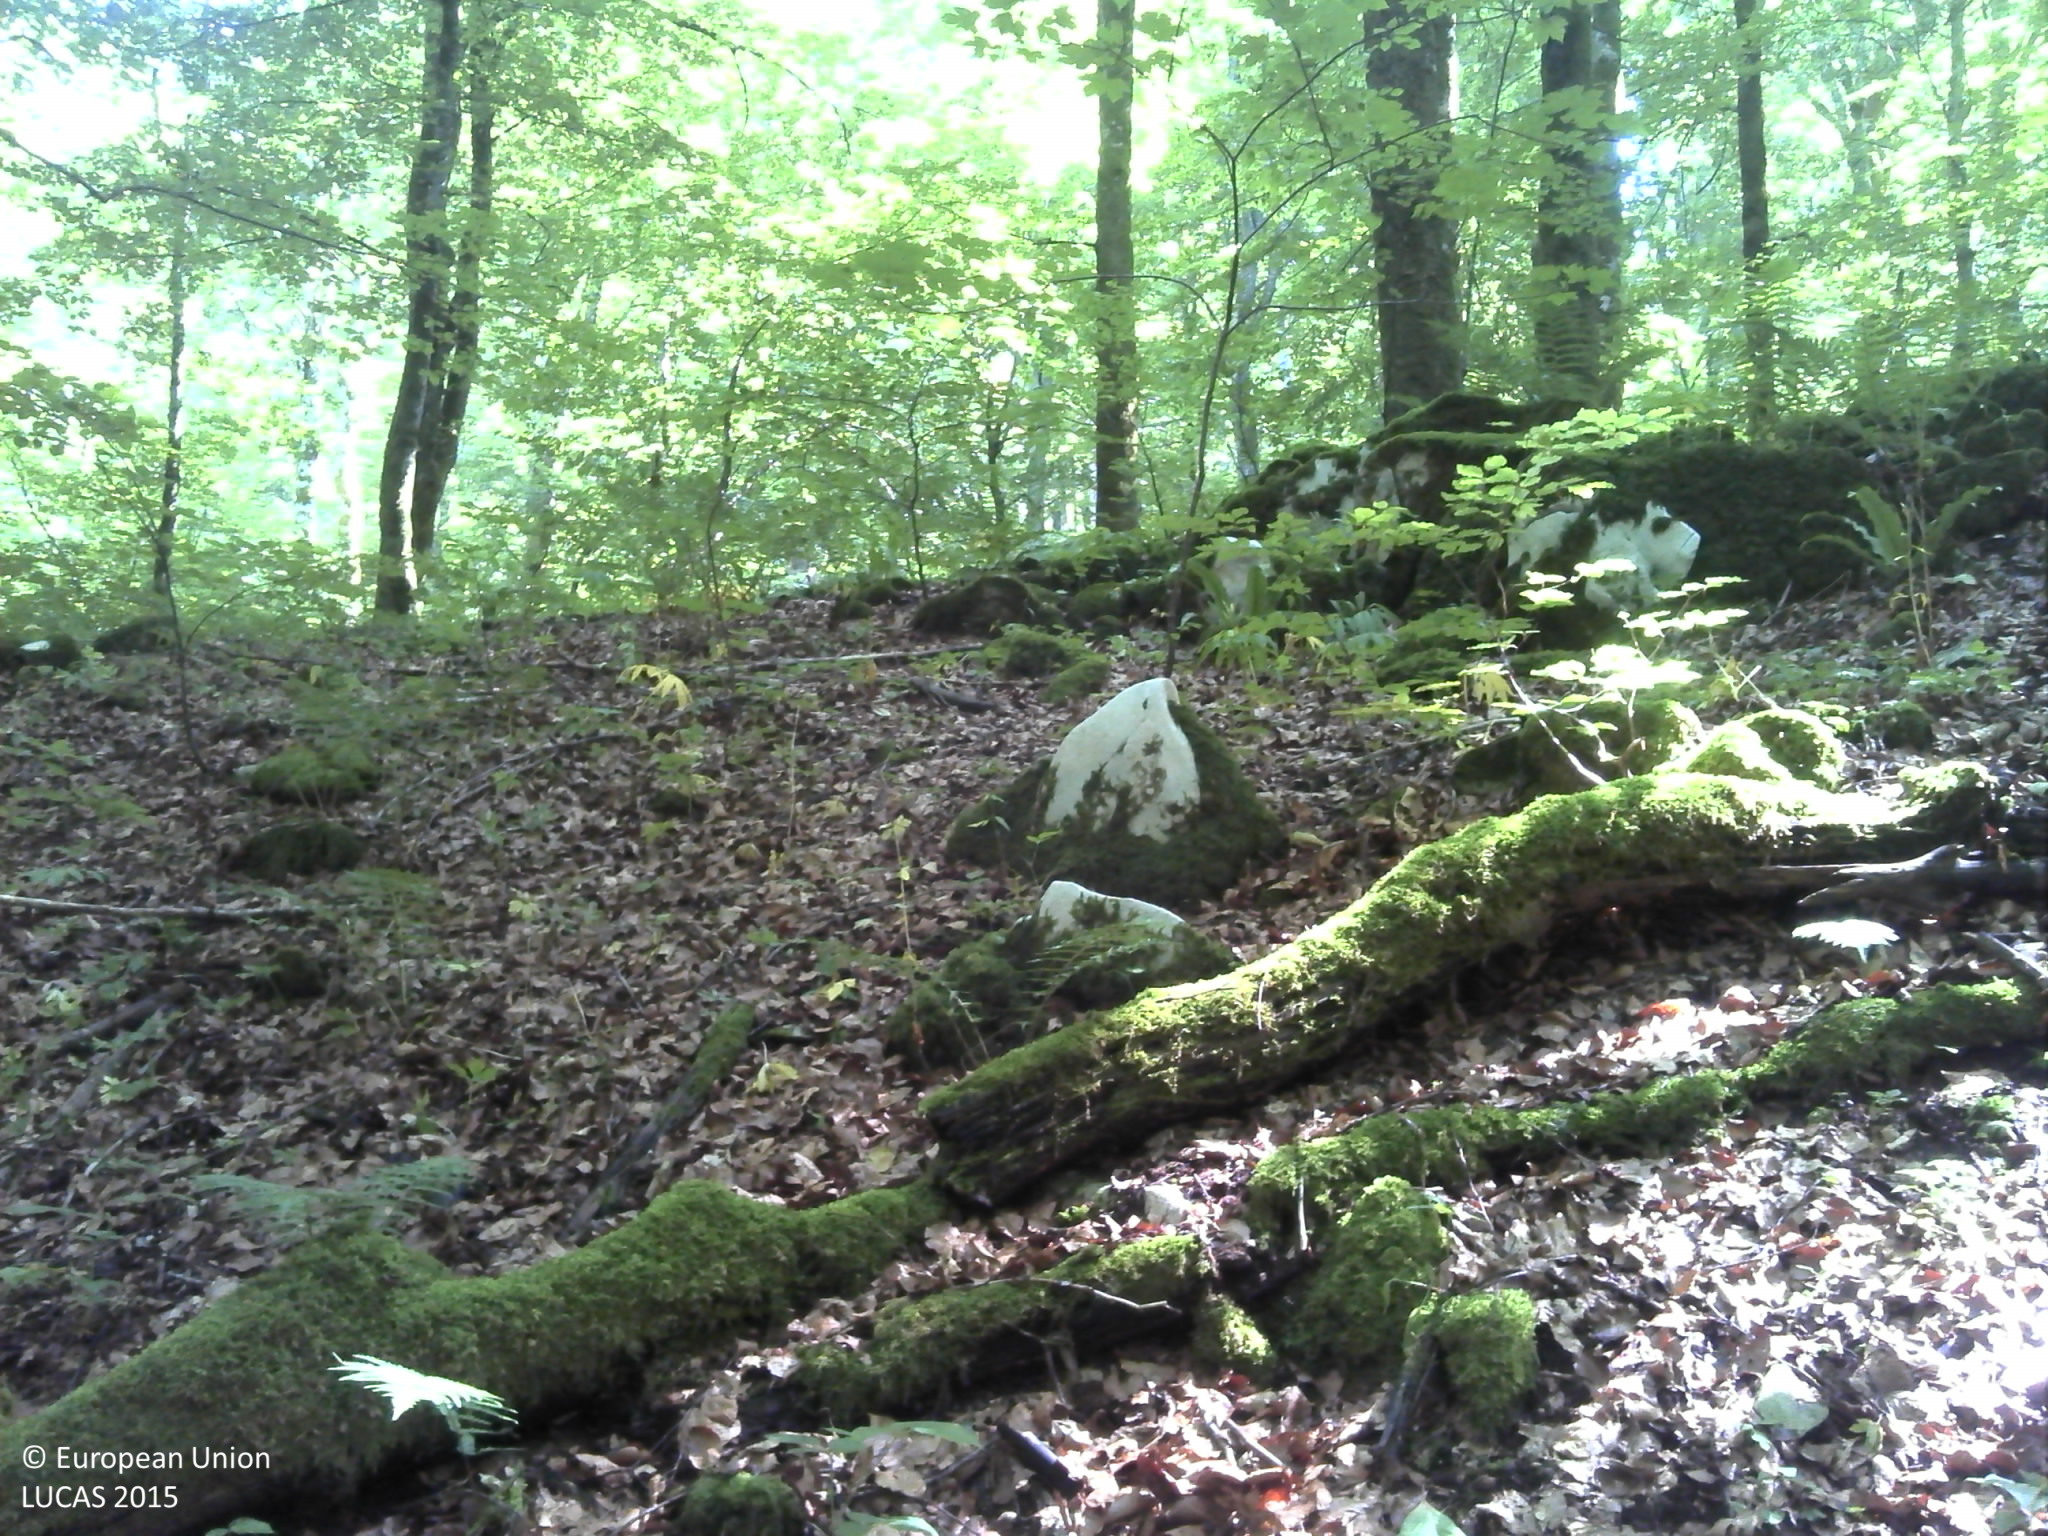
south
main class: Woodland
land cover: Broadleaved woodland
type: beech forest
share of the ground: > 75 %
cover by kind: broadleaved forest trees 95 %, consolidated bare surface 5 %
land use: Forestry
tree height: > 5 m
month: June
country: HR
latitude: 44.8845
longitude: 15.6285
